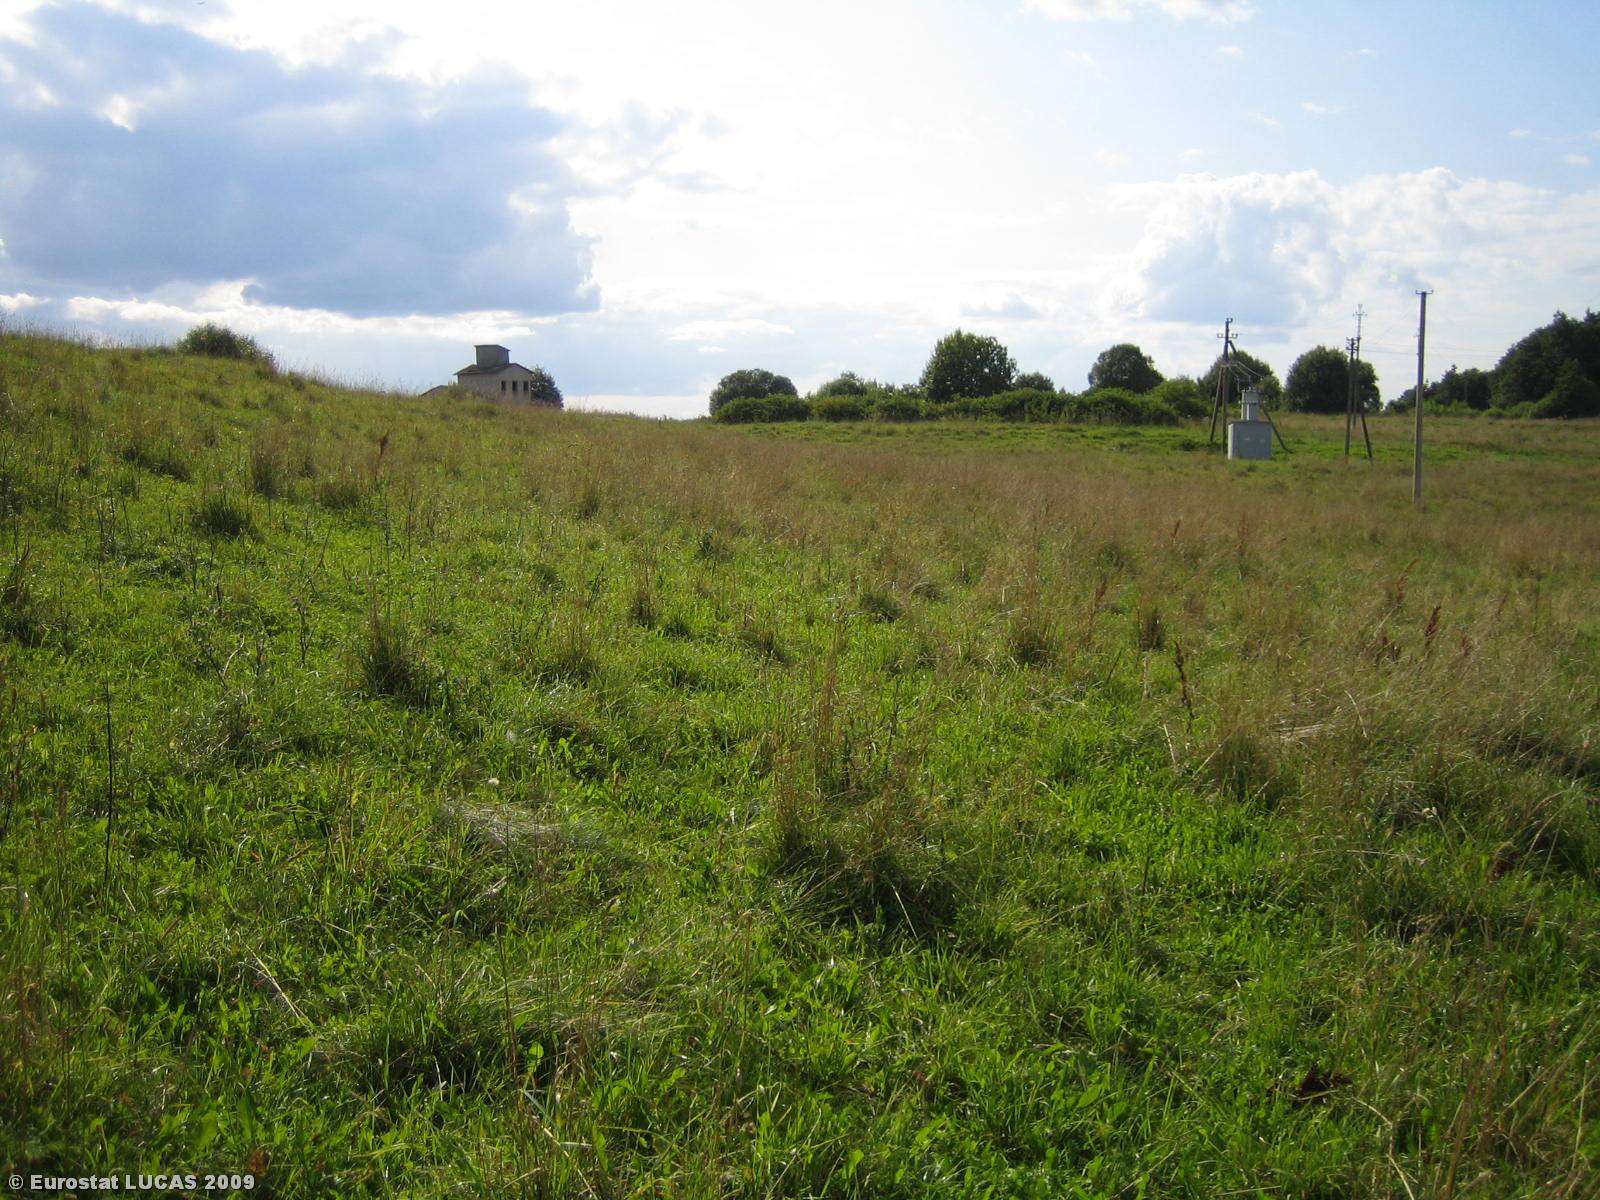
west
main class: Grassland
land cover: Grassland without tree/shrub cover
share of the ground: > 75 %
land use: Agriculture (excluding fallow land and kitchen gardens)
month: August
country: LT
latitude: 54.6795
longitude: 24.5112
